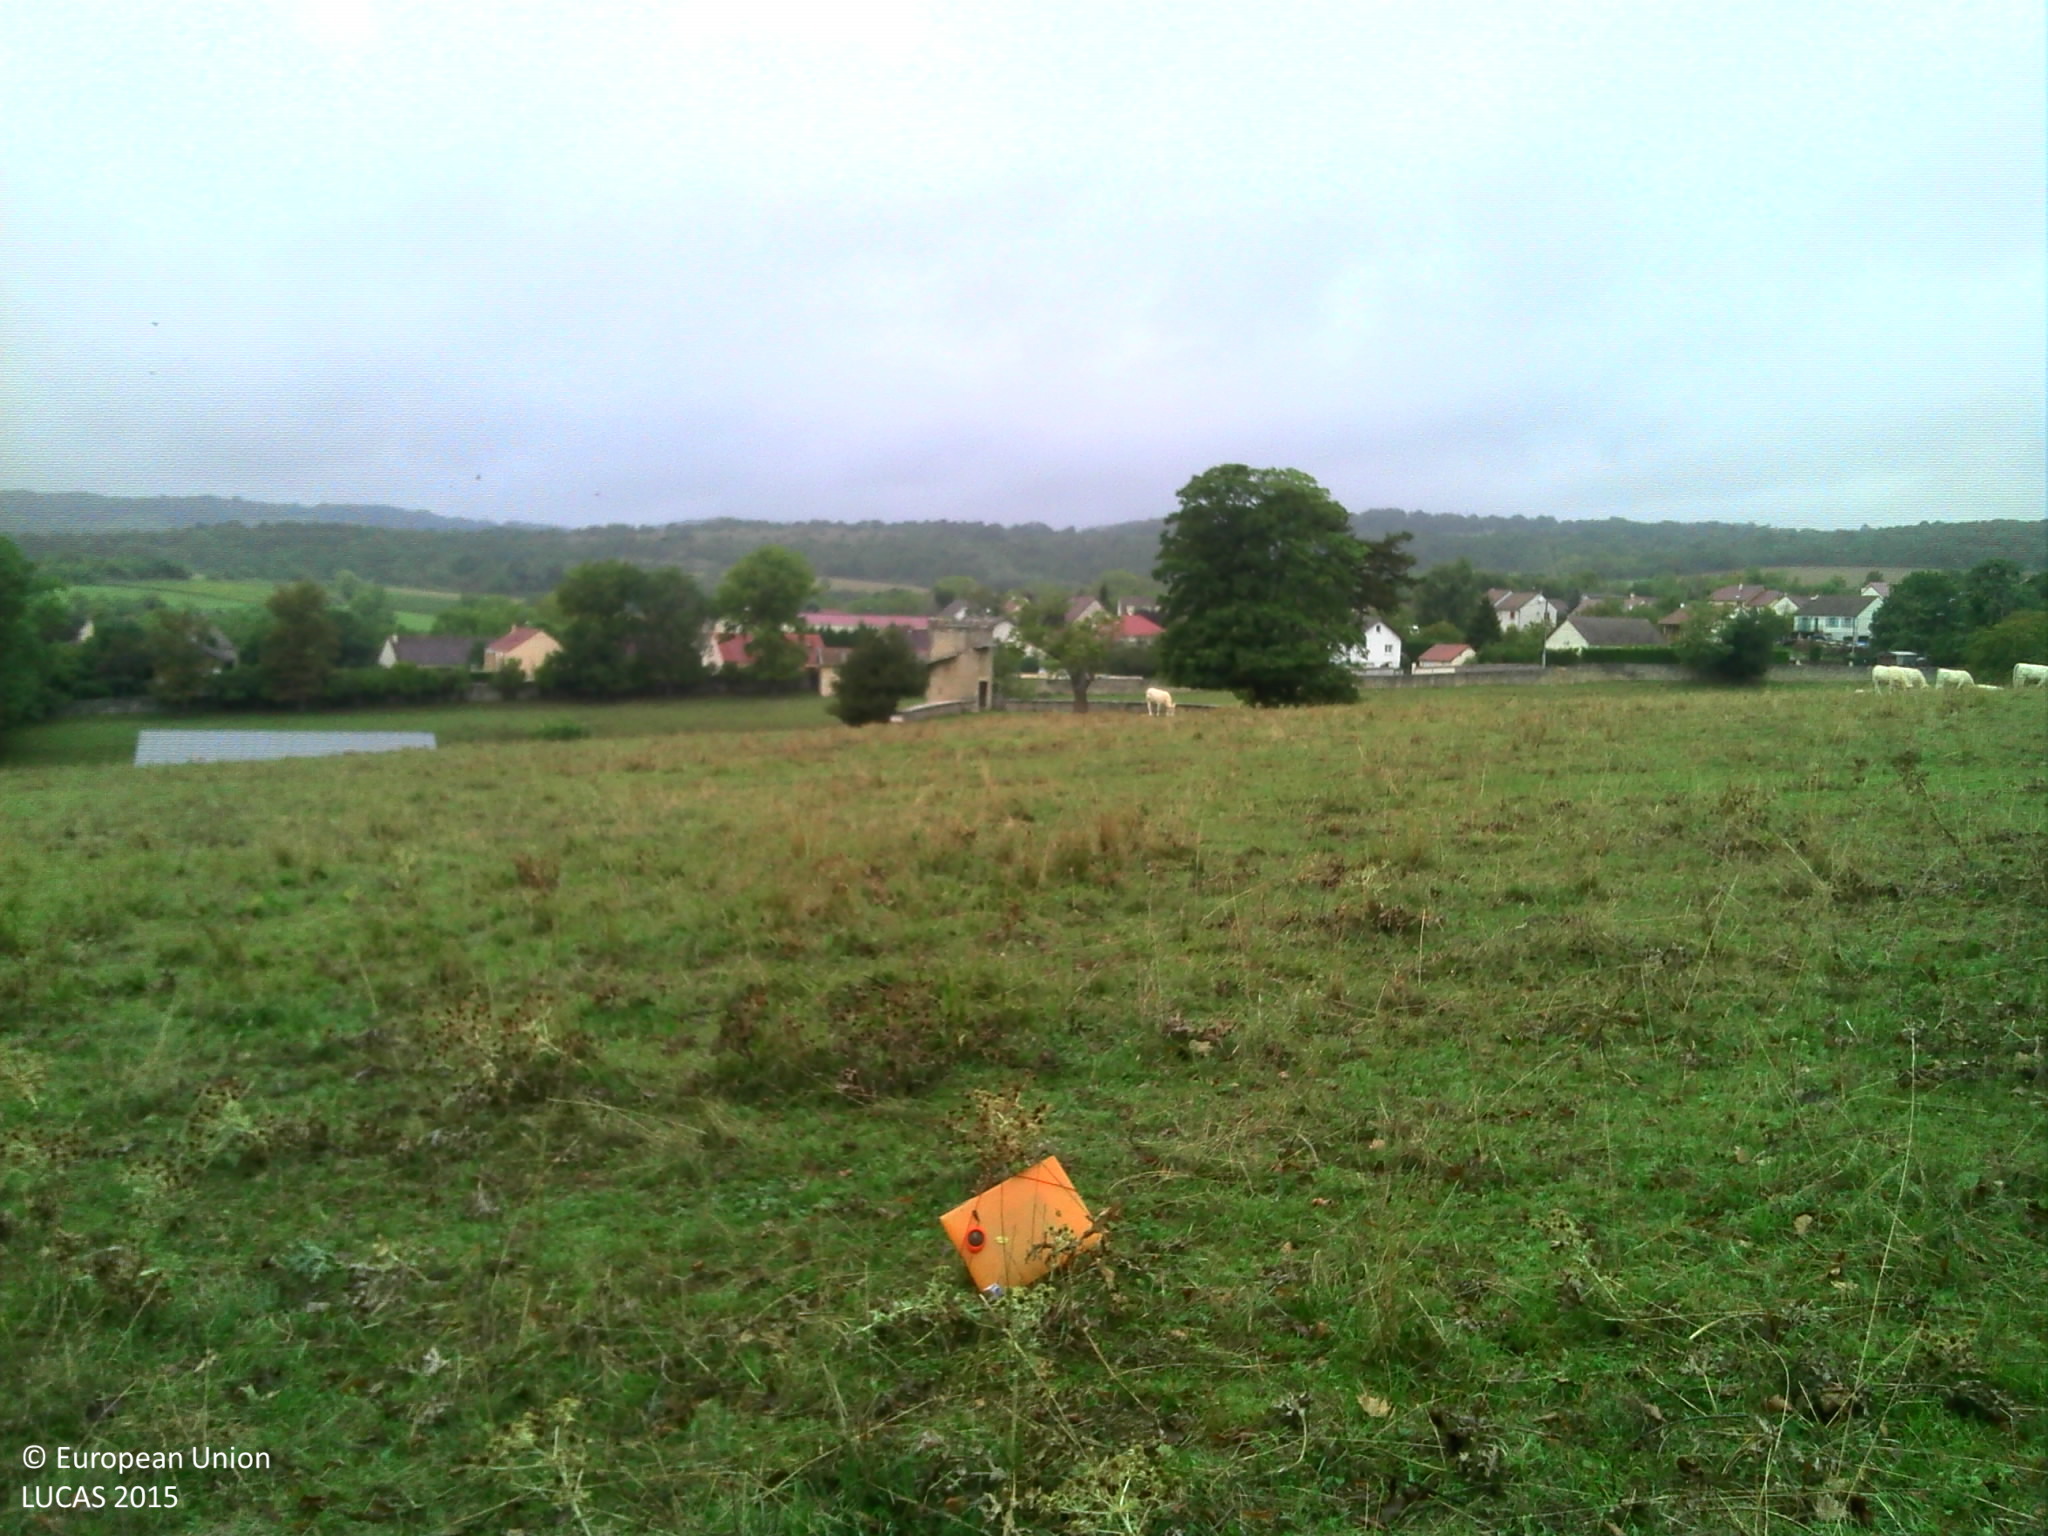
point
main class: Grassland
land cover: Grassland without tree/shrub cover
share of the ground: > 75 %
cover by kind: herbaceous plants 100 %
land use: Agriculture (excluding fallow land and kitchen gardens)
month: September
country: FR
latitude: 47.0536
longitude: 4.7744
